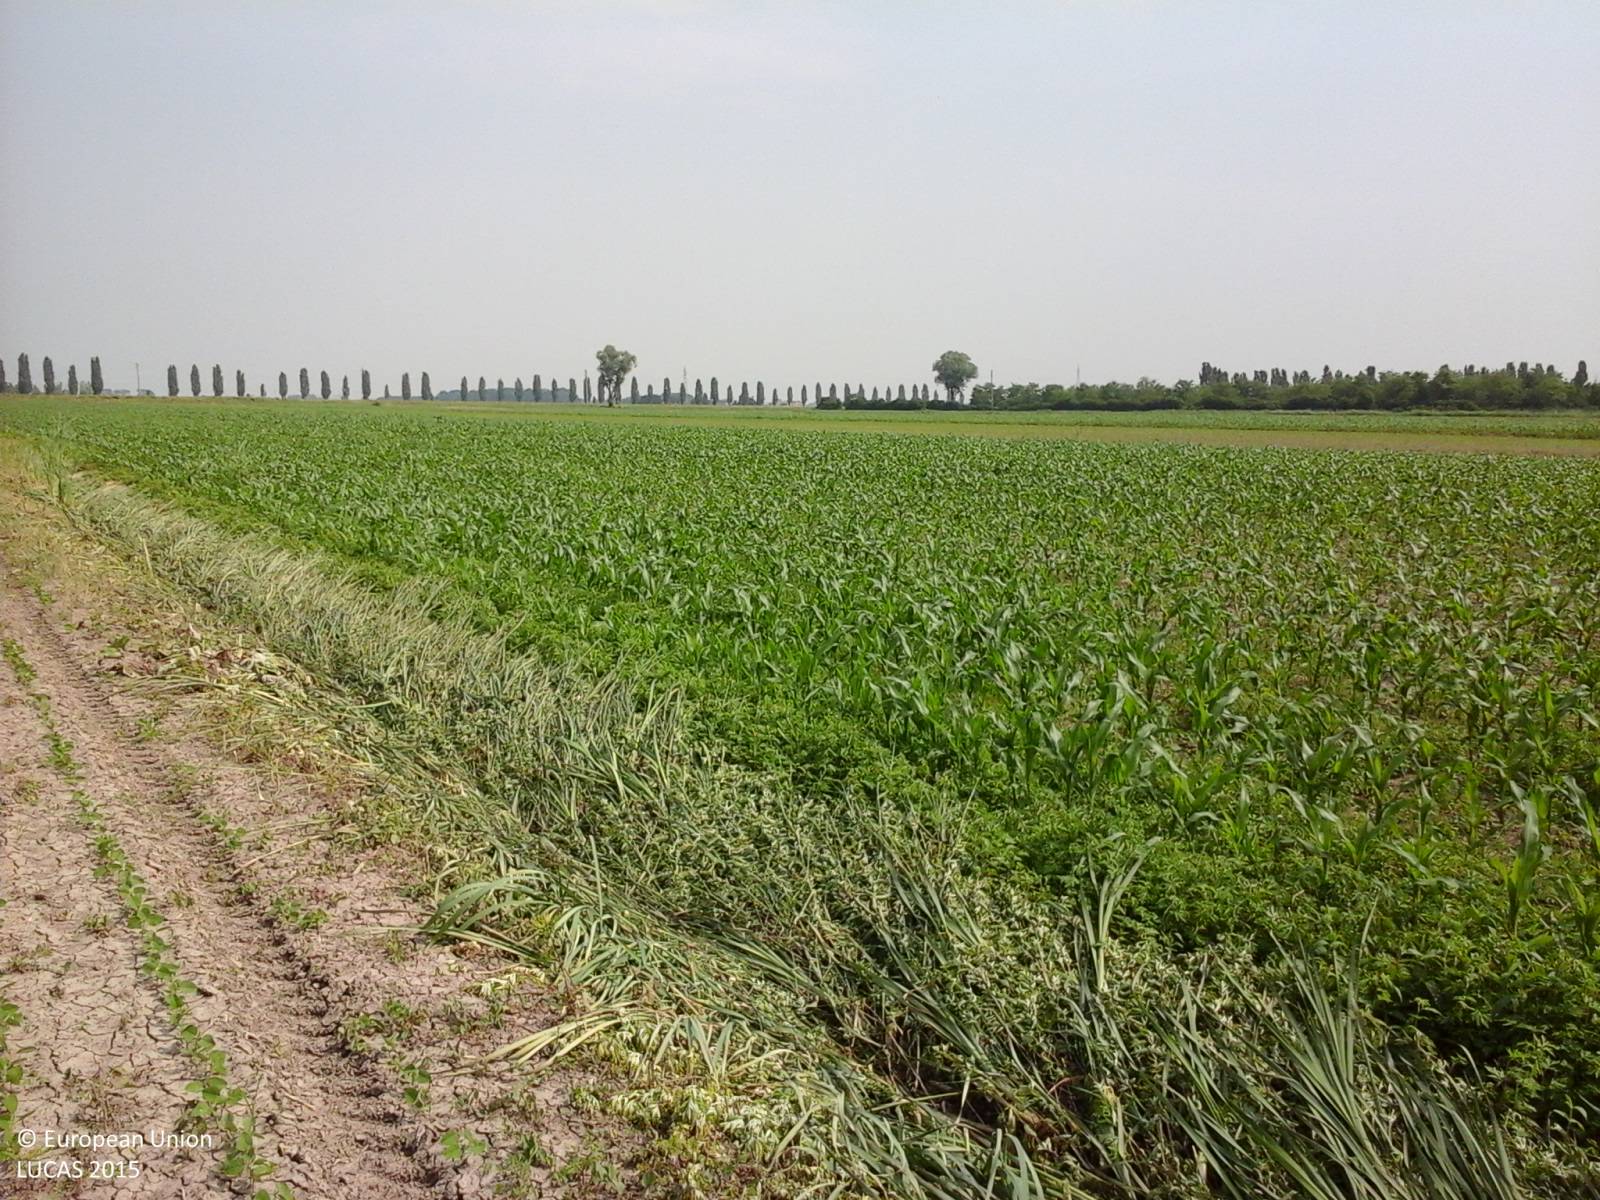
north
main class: Cropland
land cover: Soya
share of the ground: < 10 %
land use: Agriculture (excluding fallow land and kitchen gardens)
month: May
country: IT
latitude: 45.7594
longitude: 13.3001
